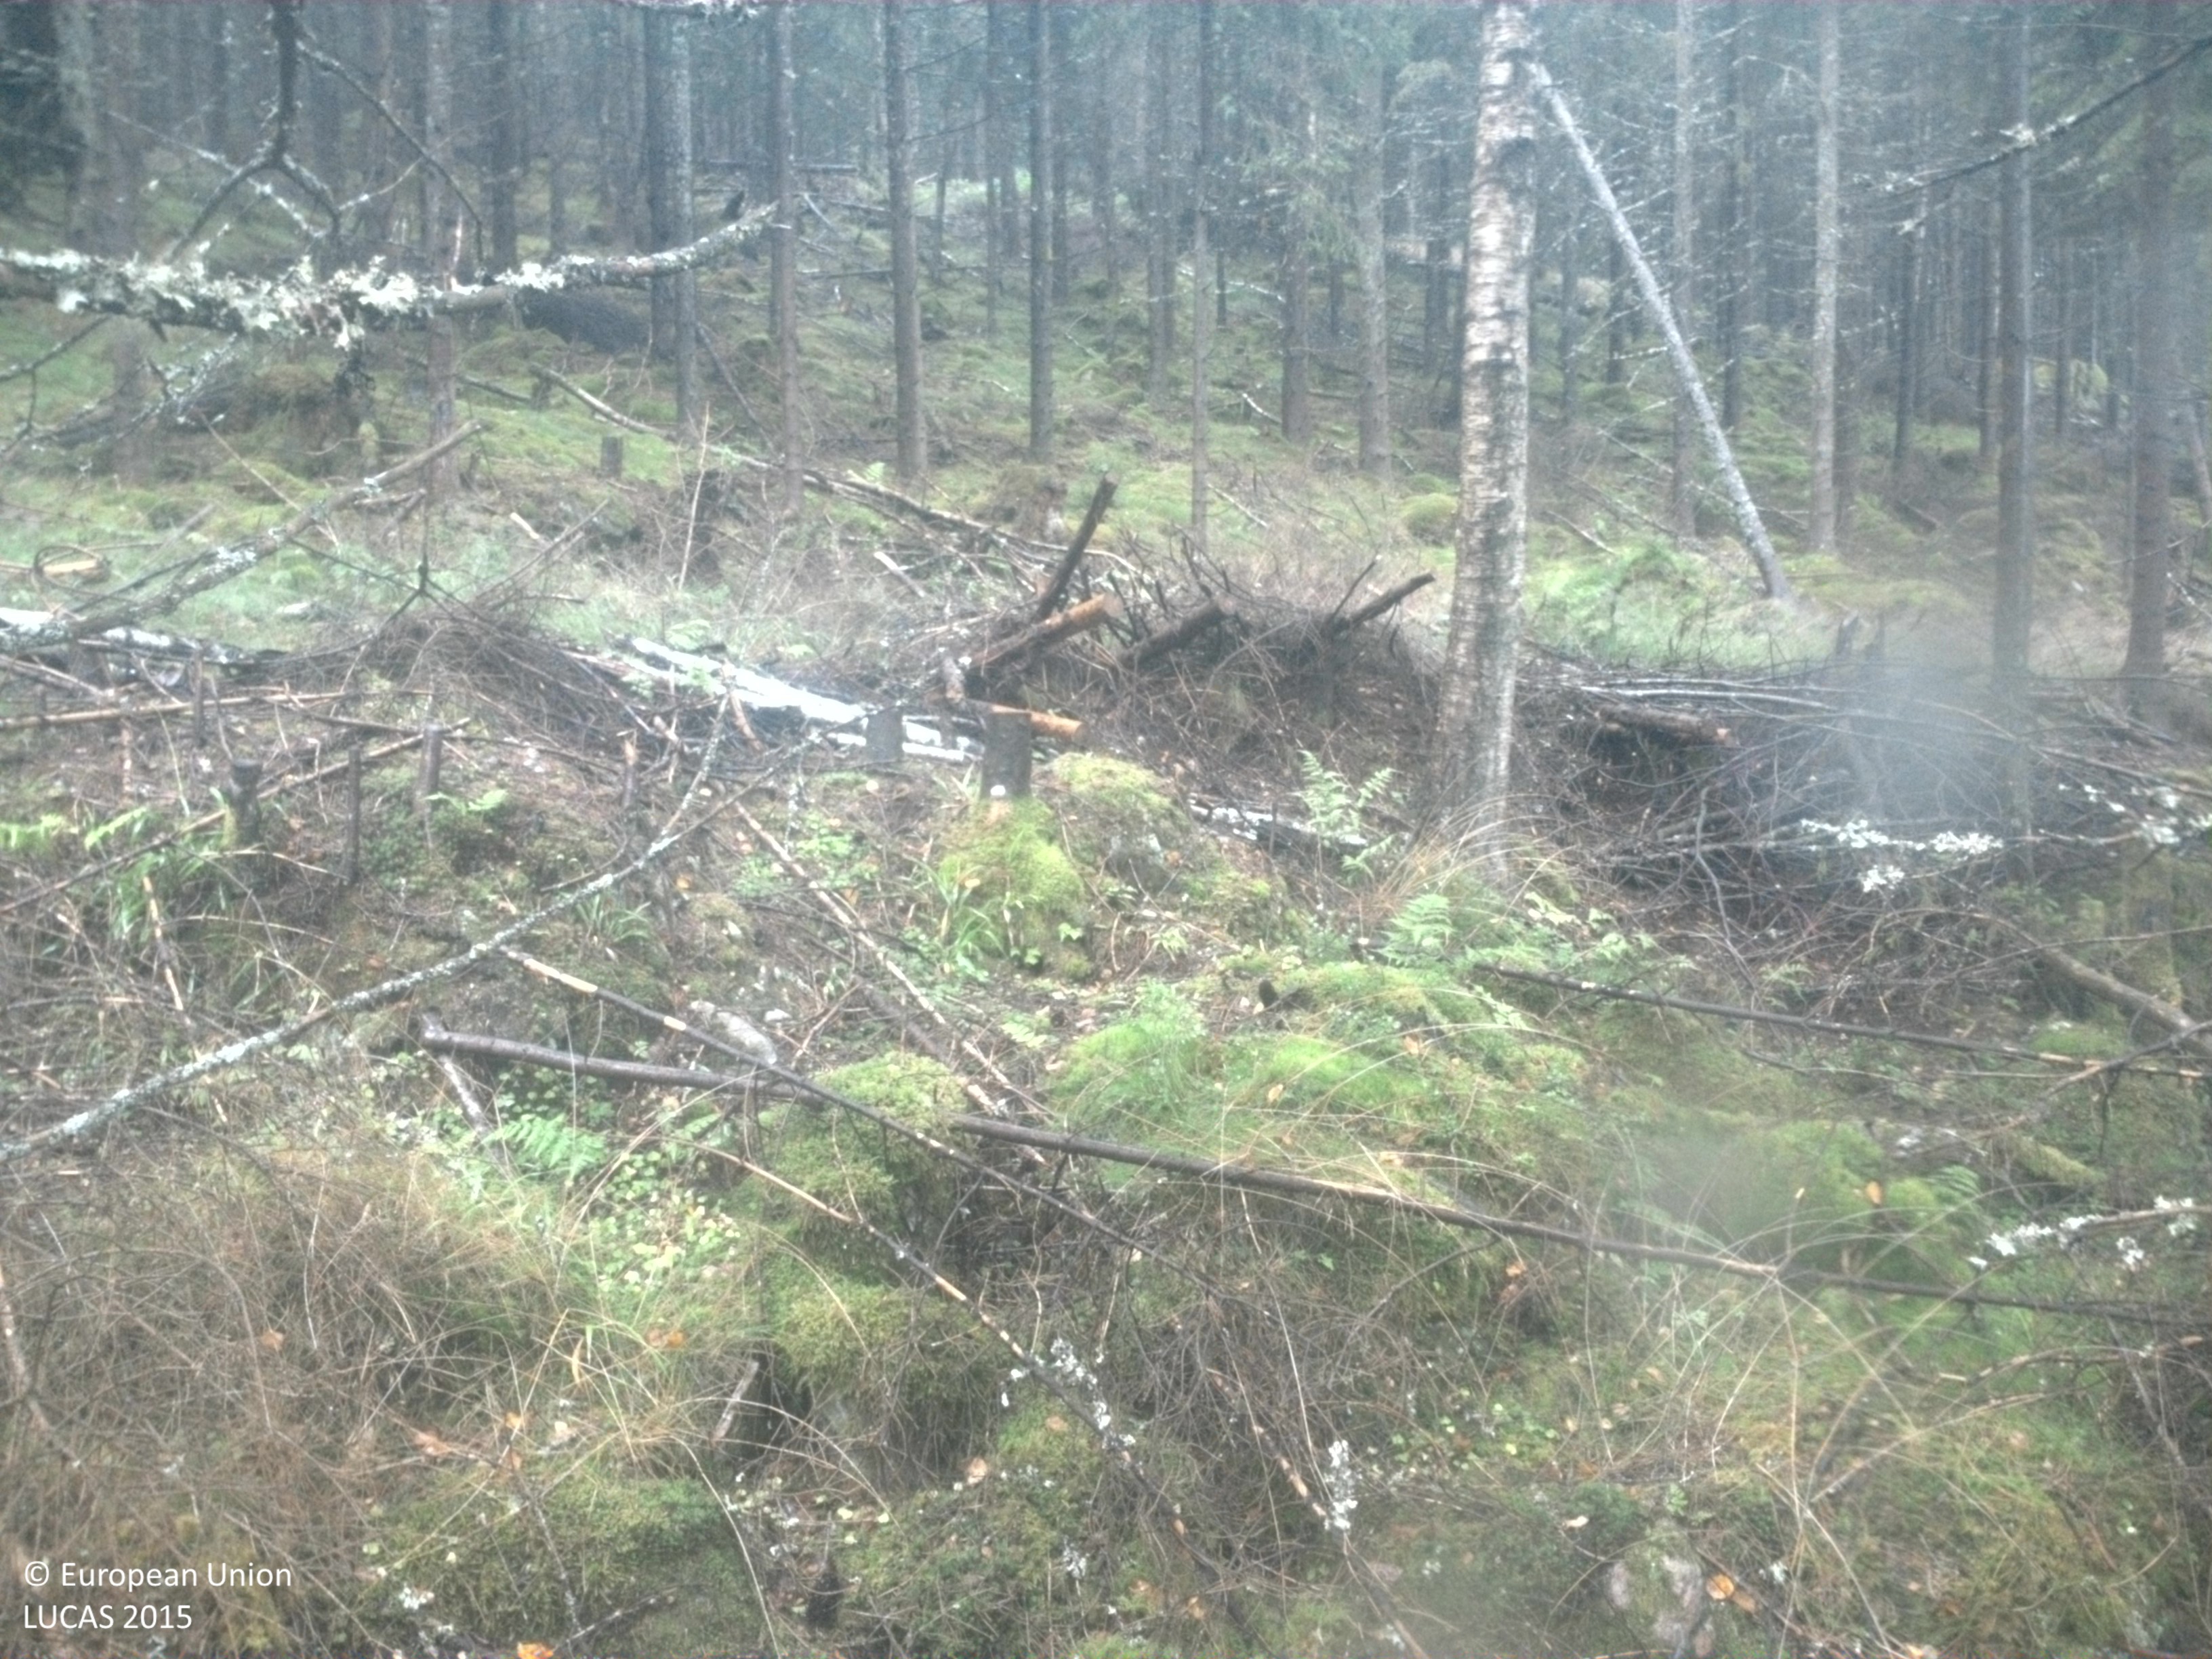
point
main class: Woodland
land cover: Spruce dominated coniferous woodland
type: boreal forest
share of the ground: 50 - 75 %
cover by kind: coniferous forest trees 60 %, lichens and mosses 20 %, herbaceous plants 10 %, broadleaved forest trees 5 %, shrubs 5 %
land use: Forestry
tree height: > 5 m
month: August
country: SE
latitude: 57.7298
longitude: 13.2699
